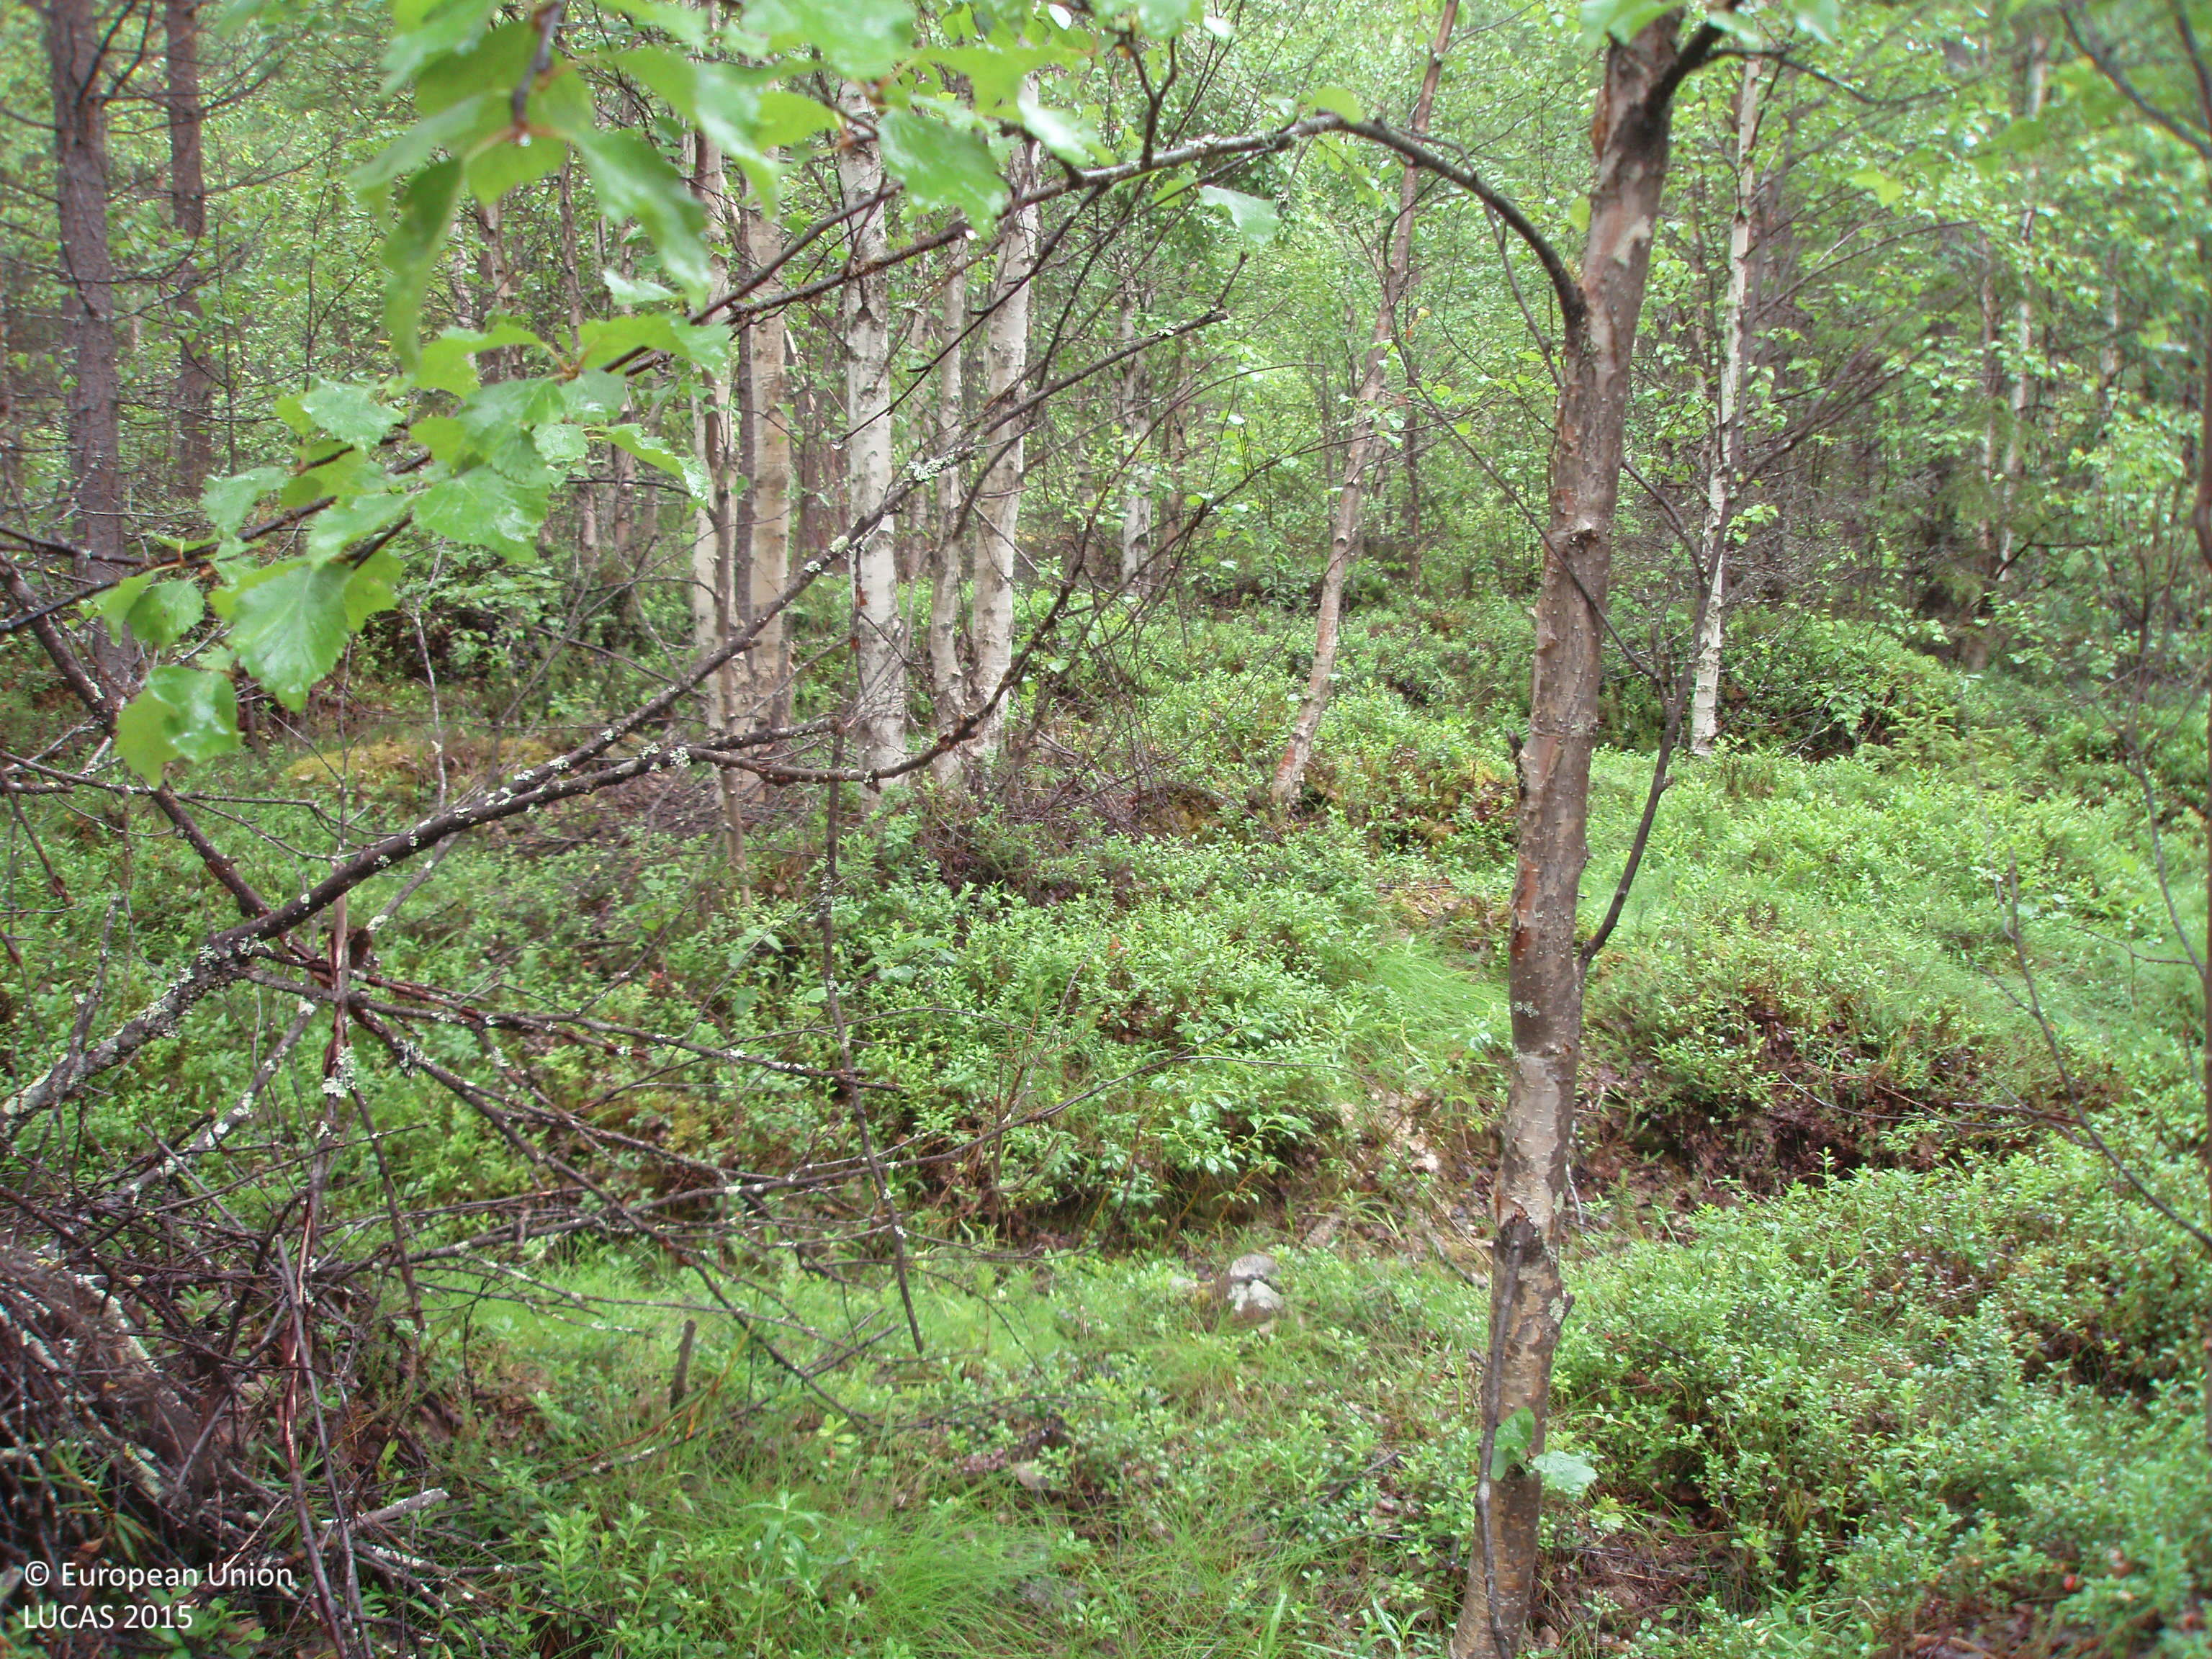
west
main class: Woodland
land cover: Pine dominated mixed woodland
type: boreal forest
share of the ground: > 75 %
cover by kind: broadleaved forest trees 50 %, coniferous forest trees 40 %, shrubs 10 %
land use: Forestry
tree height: > 5 m
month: July
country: FI
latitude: 66.8000
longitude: 28.2630
